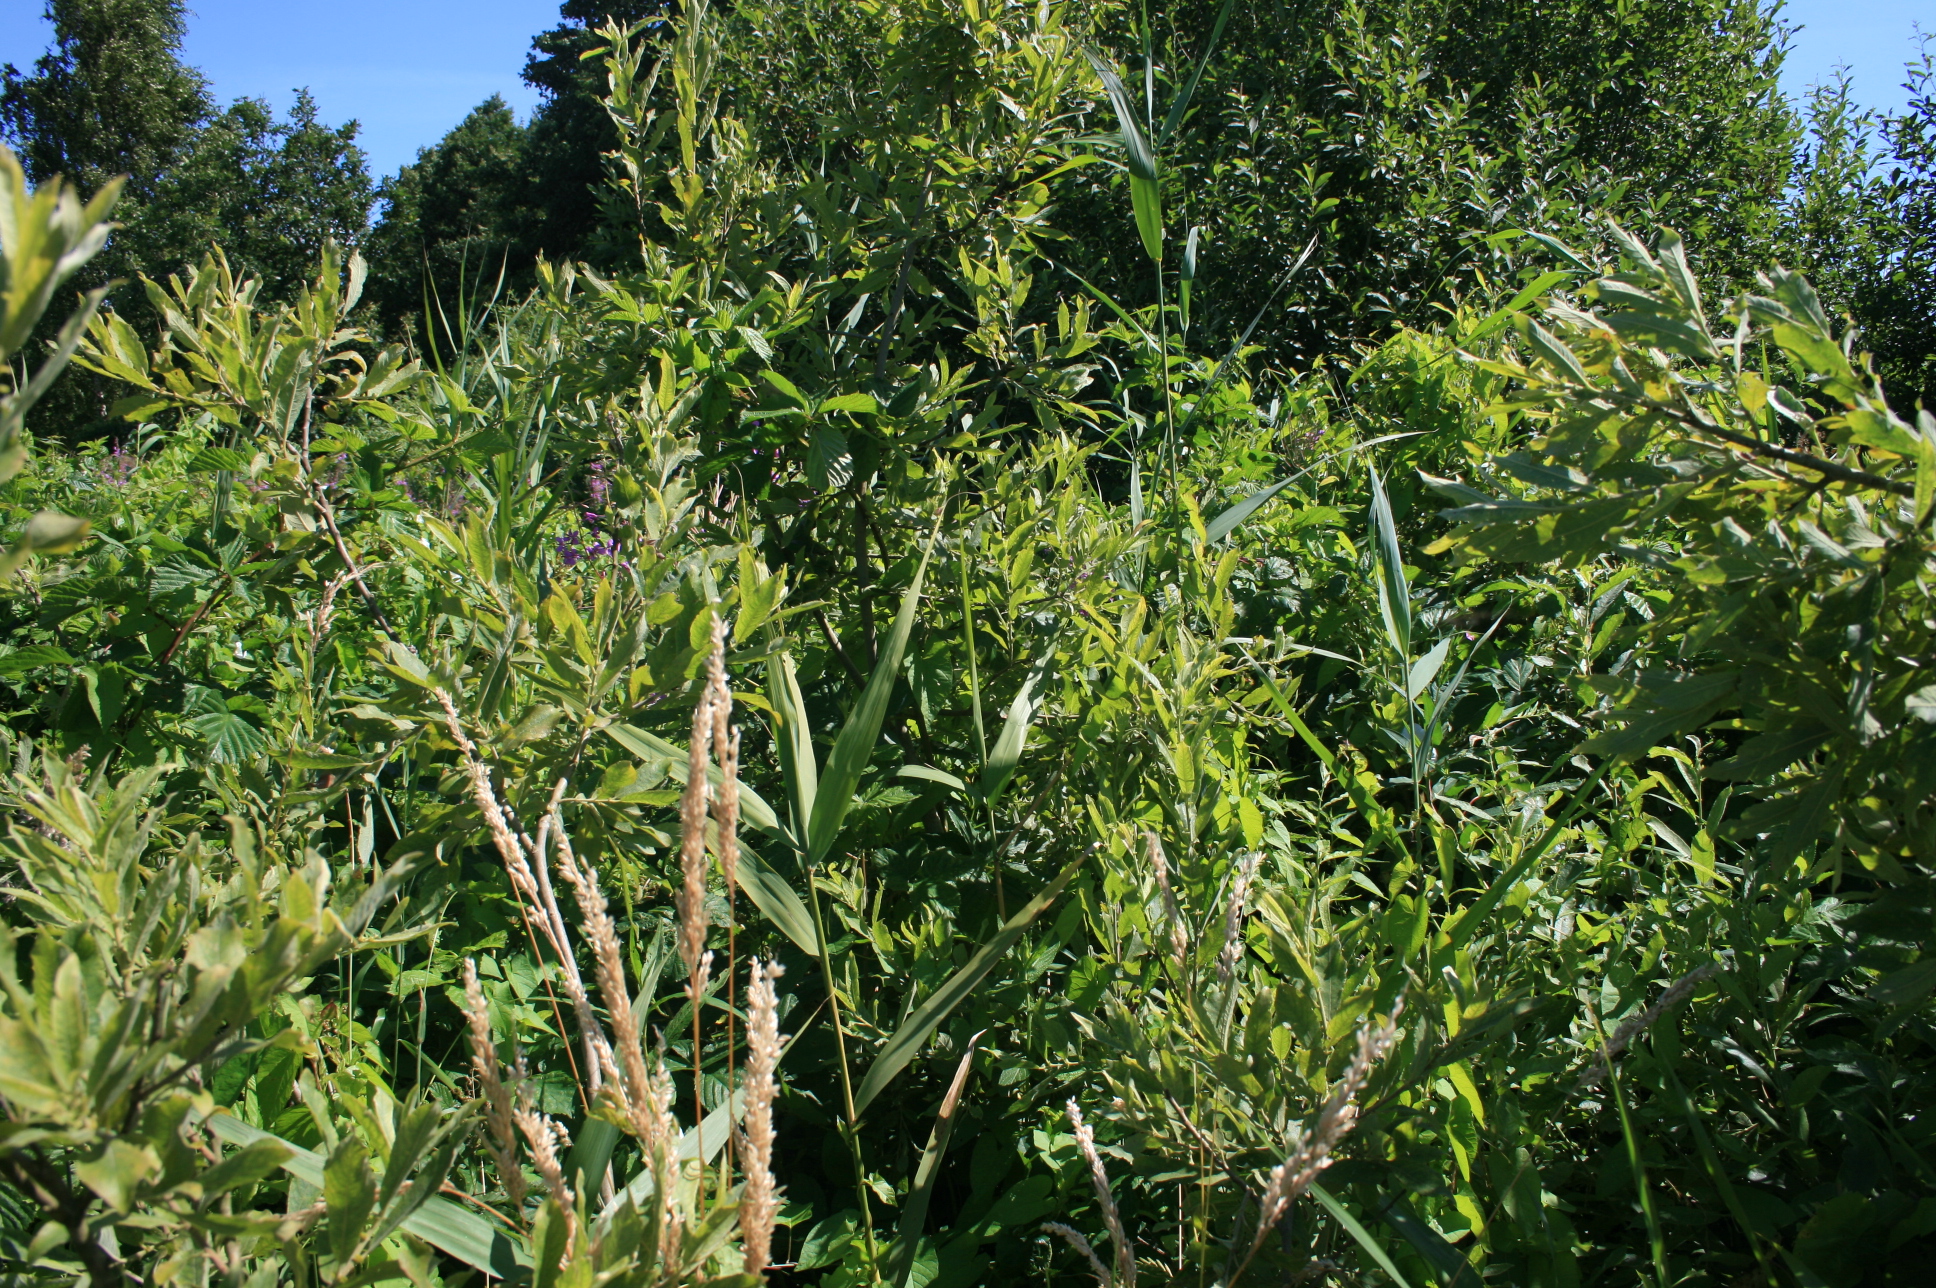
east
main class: Shrubland
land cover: Shrubland with sparse tree cover
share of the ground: 50 - 75 %
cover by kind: herbaceous plants 65 %, shrubs 30 %, broadleaved forest trees 5 %
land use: Semi-natural and natural areas not in use
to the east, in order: Shrubland with sparse tree cover; Broadleaved woodland; Ditches and canals; Broadleaved woodland; Electric lines; Broadleaved woodland; Paved roads, cycling and walking lanes; Broadleaved woodland; Ditches and canals; Broadleaved woodland; Fences; Grassland without tree/shrub cover; Arable land (only in case pi); Grassland without tree/shrub cover
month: July
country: LT
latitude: 55.4725
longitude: 21.2587
